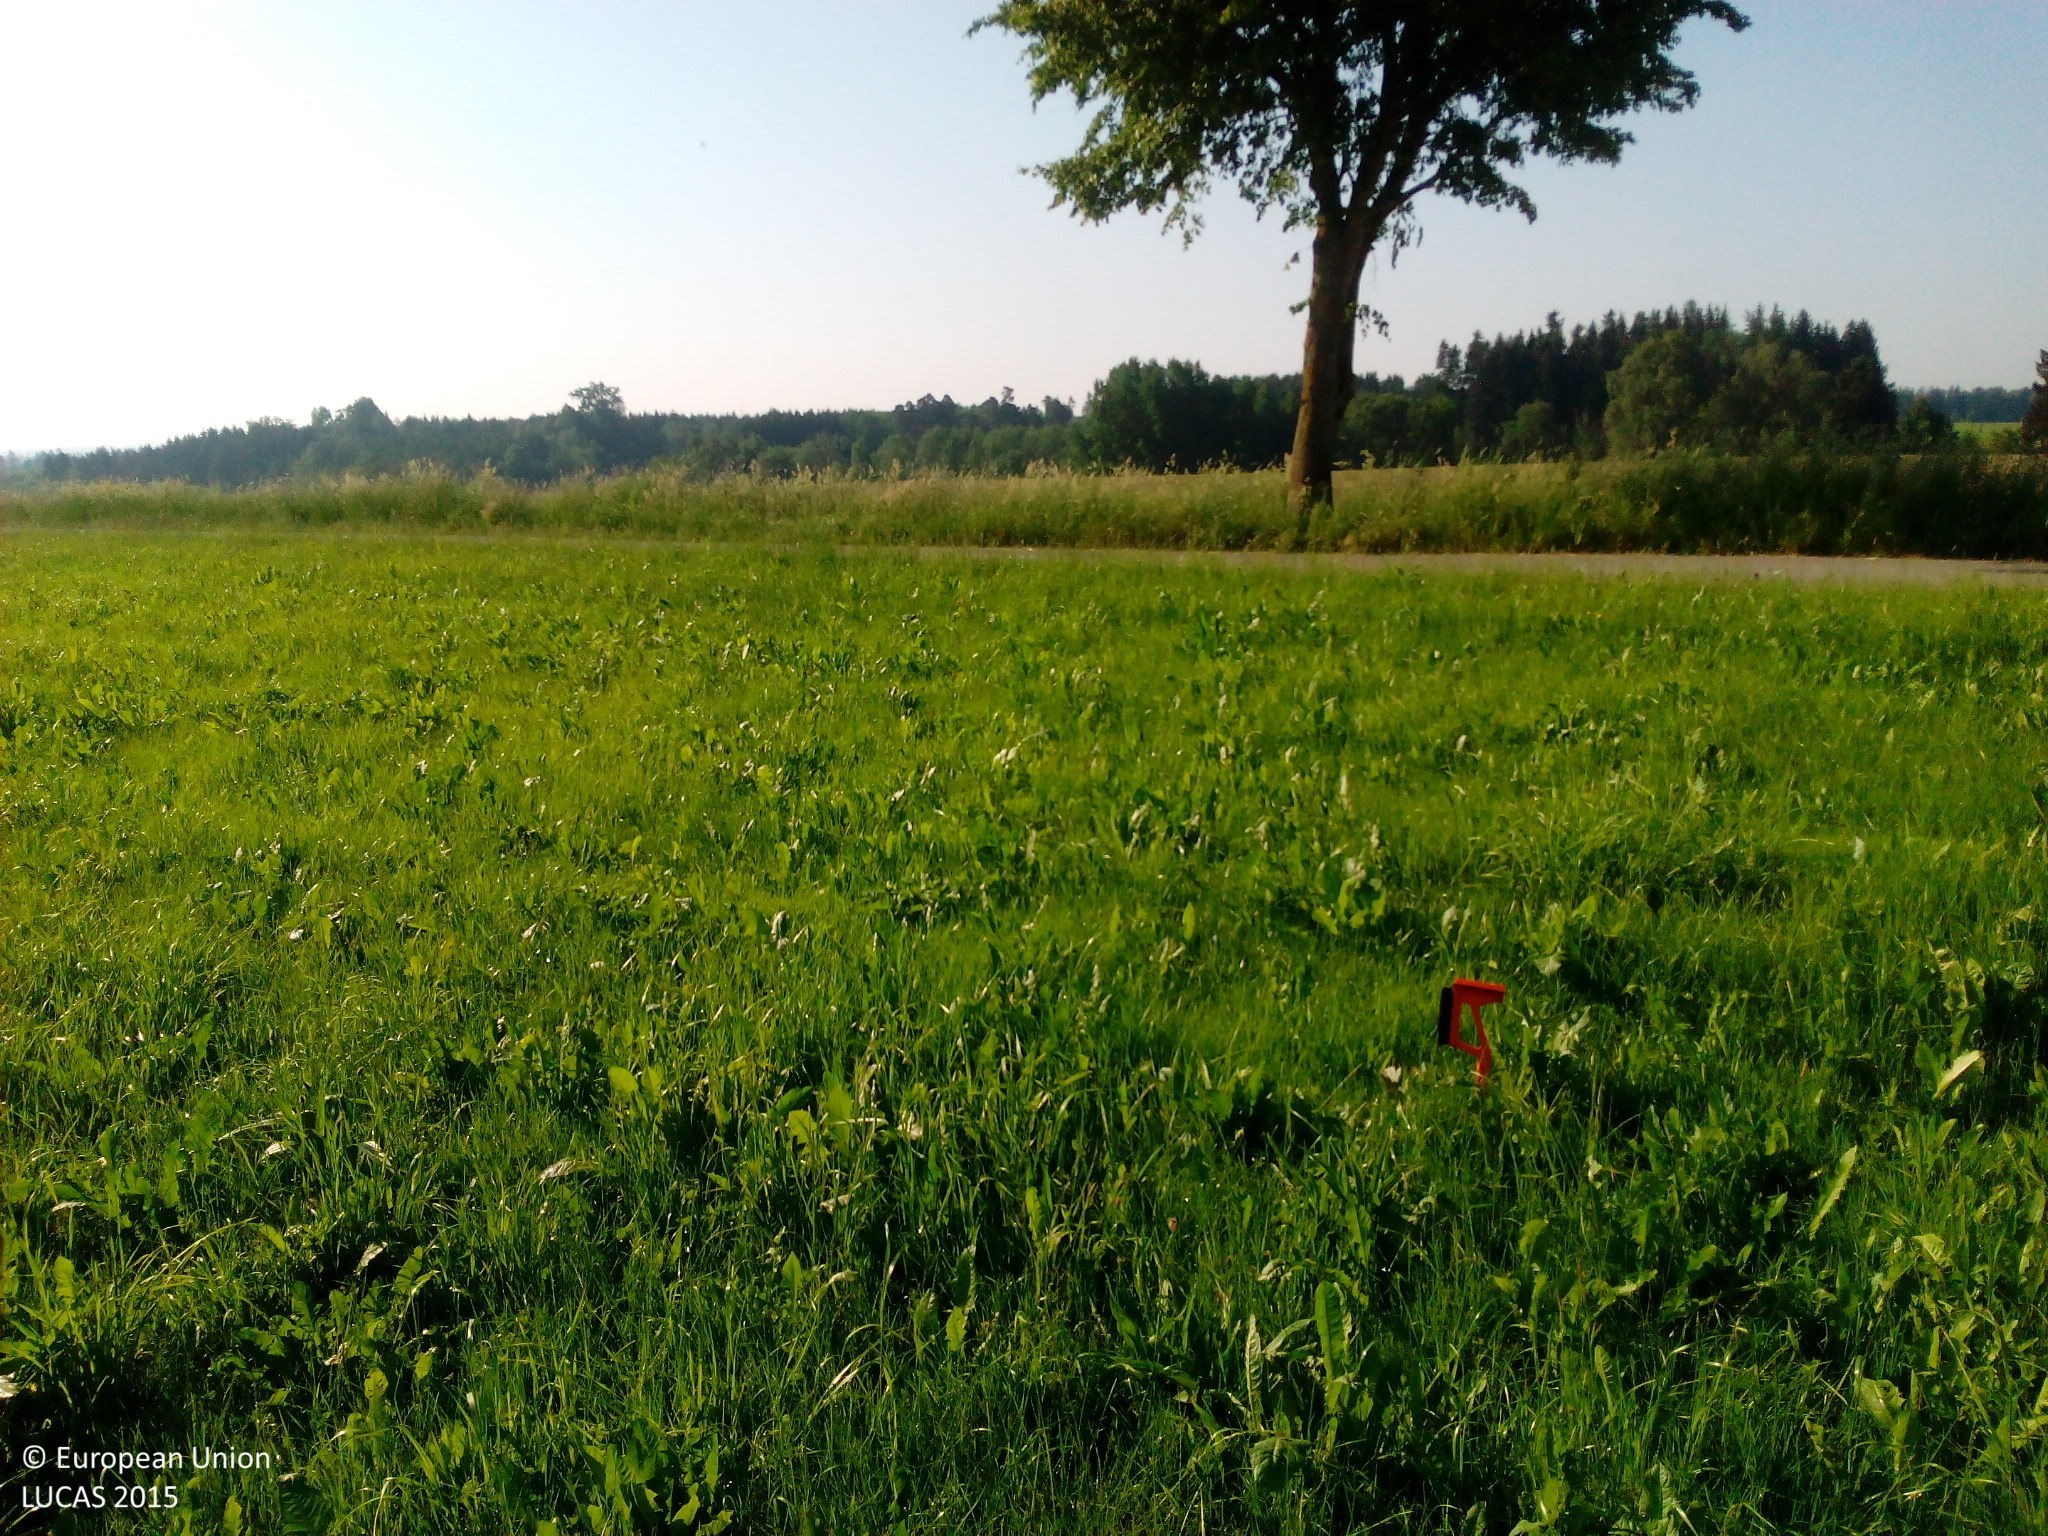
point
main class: Grassland
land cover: Grassland without tree/shrub cover
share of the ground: > 75 %
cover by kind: herbaceous plants 100 %
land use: Agriculture (excluding fallow land and kitchen gardens)
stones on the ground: < 10 %
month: June
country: DE
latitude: 47.9519
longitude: 10.6021
